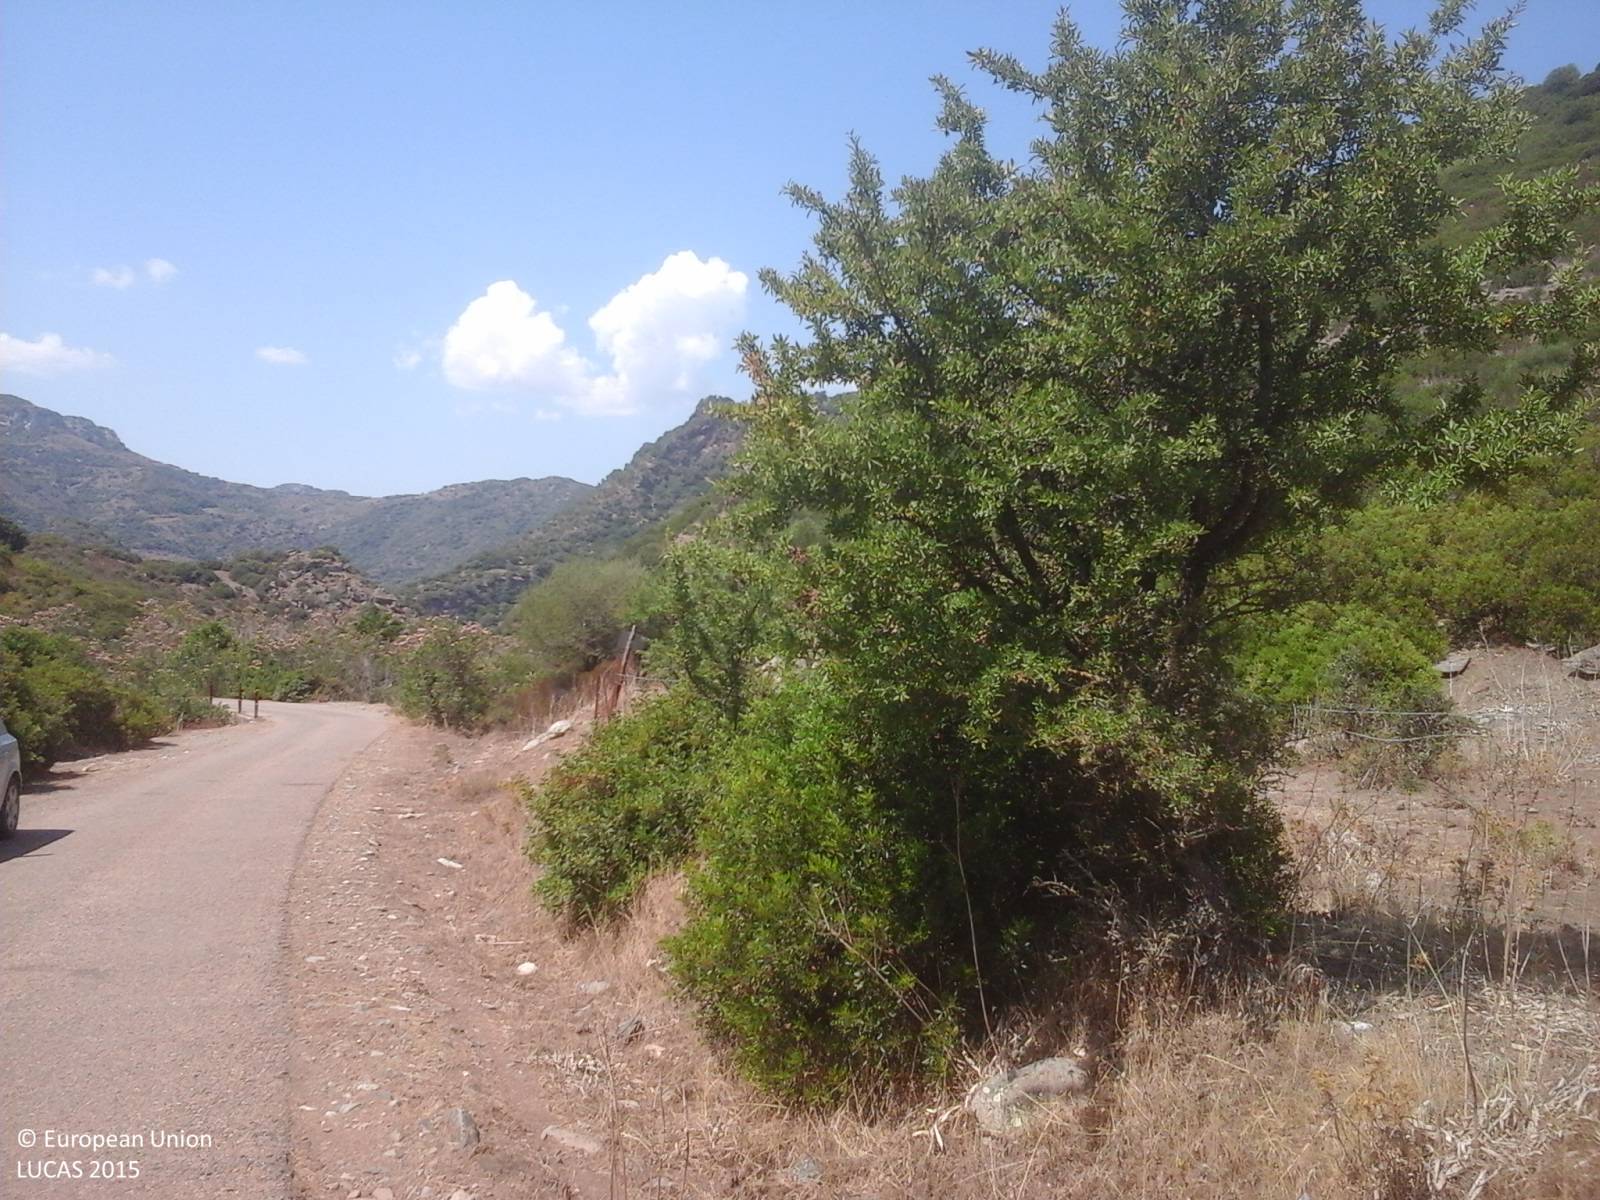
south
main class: Shrubland
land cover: Shrubland without tree cover
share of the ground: > 75 %
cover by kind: shrubs 85 %, unconsolidated bare surface 15 %
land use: Semi-natural and natural areas not in use
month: July
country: IT
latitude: 39.5232
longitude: 9.4334
